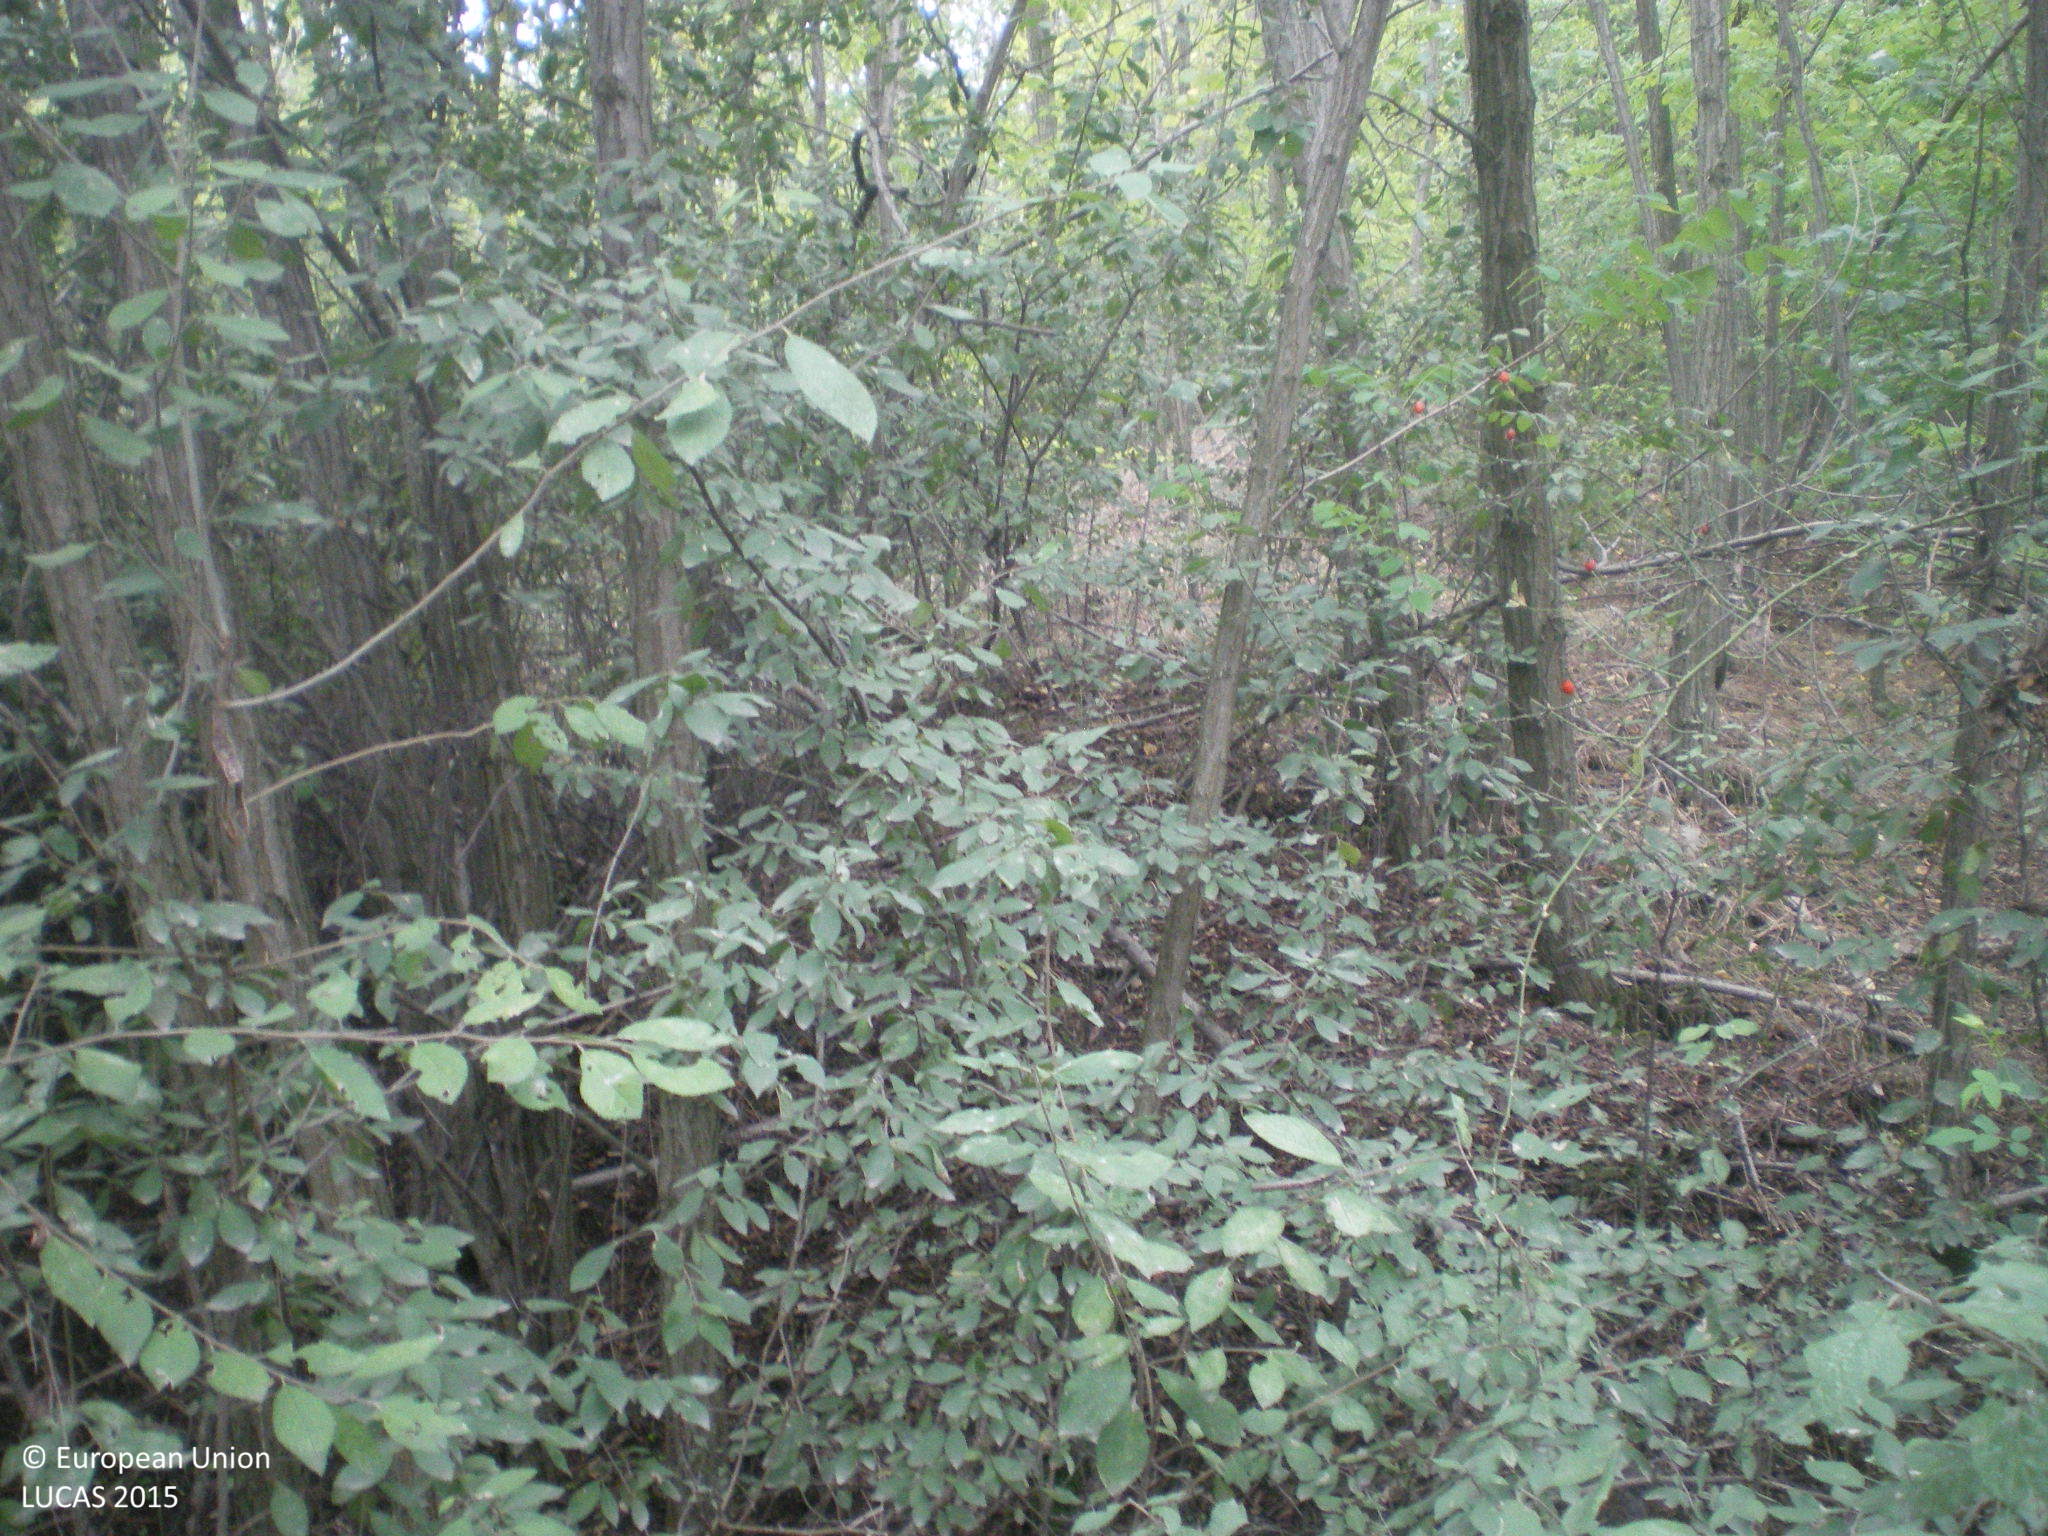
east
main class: Woodland
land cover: Broadleaved woodland
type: mesophytic deciduous forest
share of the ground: > 75 %
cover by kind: broadleaved forest trees 95 %, unconsolidated bare surface 5 %
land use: Forestry
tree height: > 5 m
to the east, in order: Broadleaved woodland; Paved roads, cycling and walking lanes; Pine dominated coniferous woodland; Electric lines; Pine dominated coniferous woodland; Grassland with sparse tree/shrub cover; Tracks
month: October
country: BG
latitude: 42.1713
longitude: 25.9456
